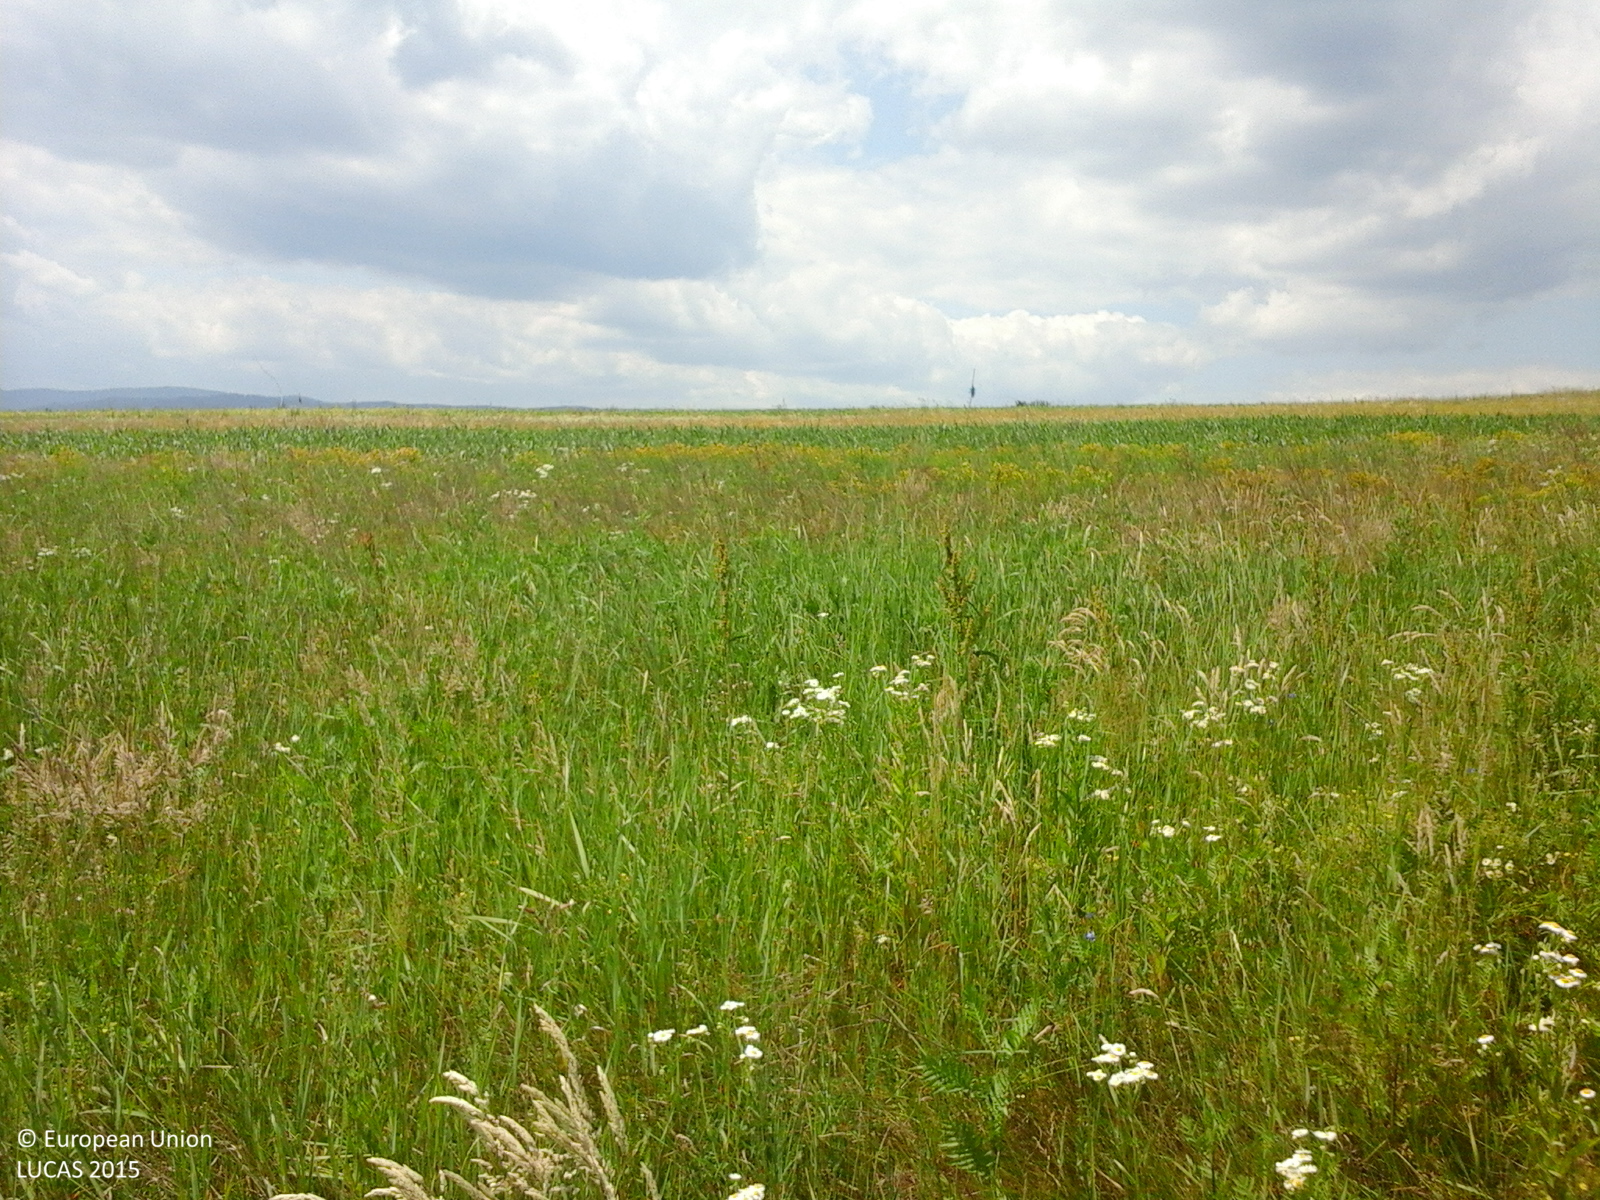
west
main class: Grassland
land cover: Grassland without tree/shrub cover
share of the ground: > 75 %
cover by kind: herbaceous plants 100 %
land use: Agriculture (excluding fallow land and kitchen gardens)
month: June
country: RO
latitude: 47.7592
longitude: 25.8829
